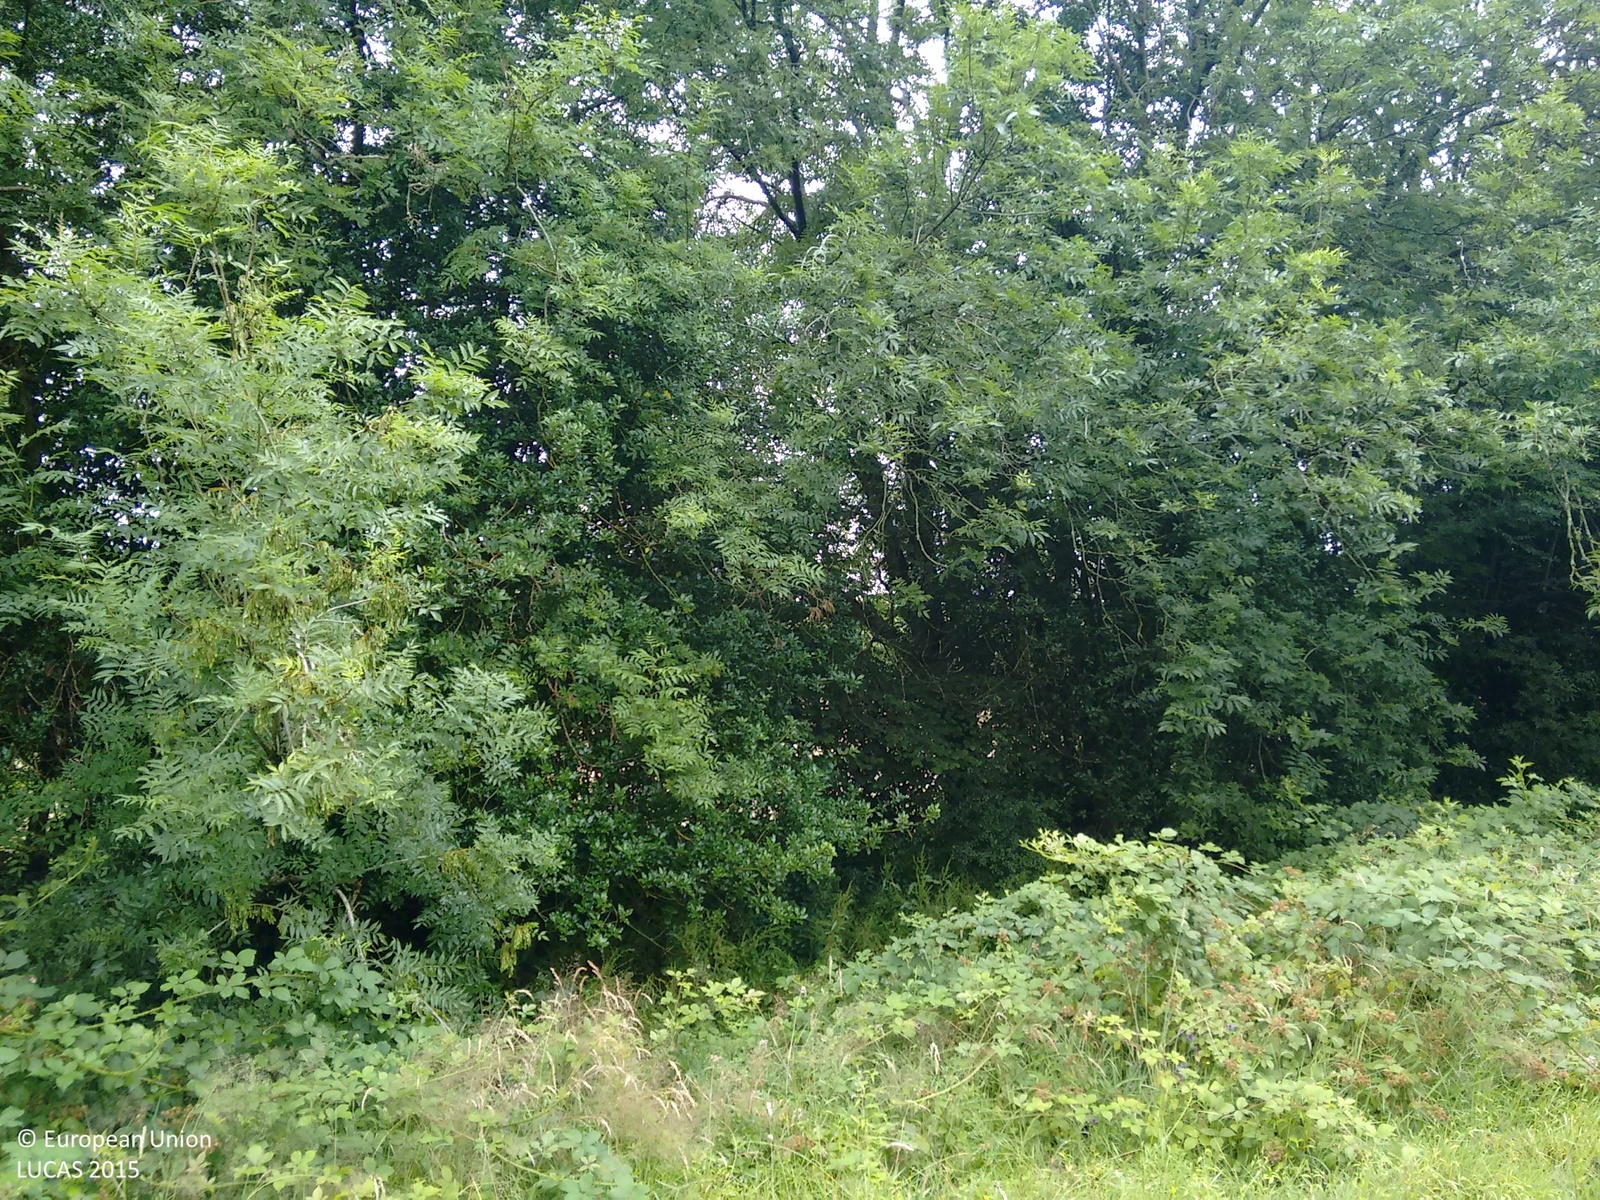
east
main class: Grassland
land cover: Grassland without tree/shrub cover
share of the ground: > 75 %
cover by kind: herbaceous plants 100 %
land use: Agriculture (excluding fallow land and kitchen gardens)
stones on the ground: < 10 %
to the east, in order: Grassland without tree/shrub cover; Fences; Managed hedges; Fences; Grassland without tree/shrub cover; Electric lines; Grassland without tree/shrub cover; Fences; Managed hedges; Electric lines; Grassland without tree/shrub cover; Fences; Managed hedges; Grassland without tree/shrub cover
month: July
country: GB
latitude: 51.6917
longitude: -3.8195
